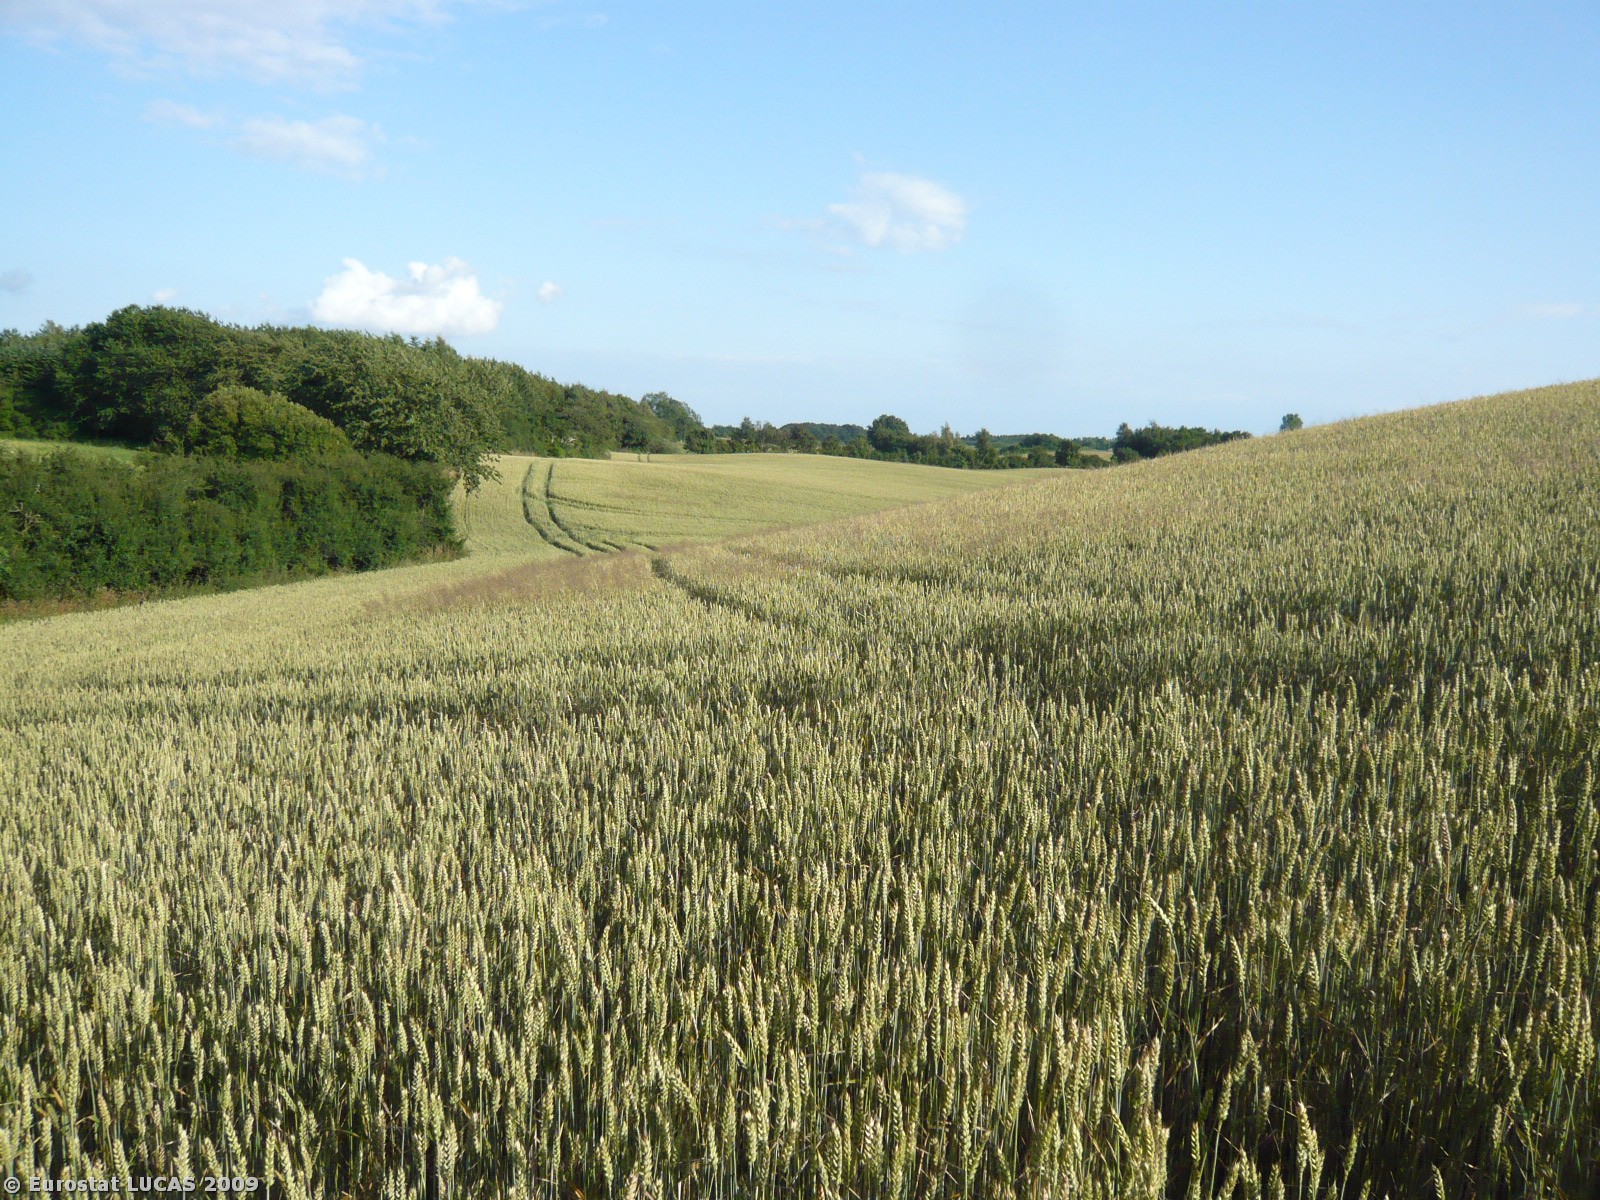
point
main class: Cropland
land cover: Common wheat
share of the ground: > 75 %
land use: Agriculture (excluding fallow land and kitchen gardens)
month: July
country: DK
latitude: 55.6043
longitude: 11.4431
